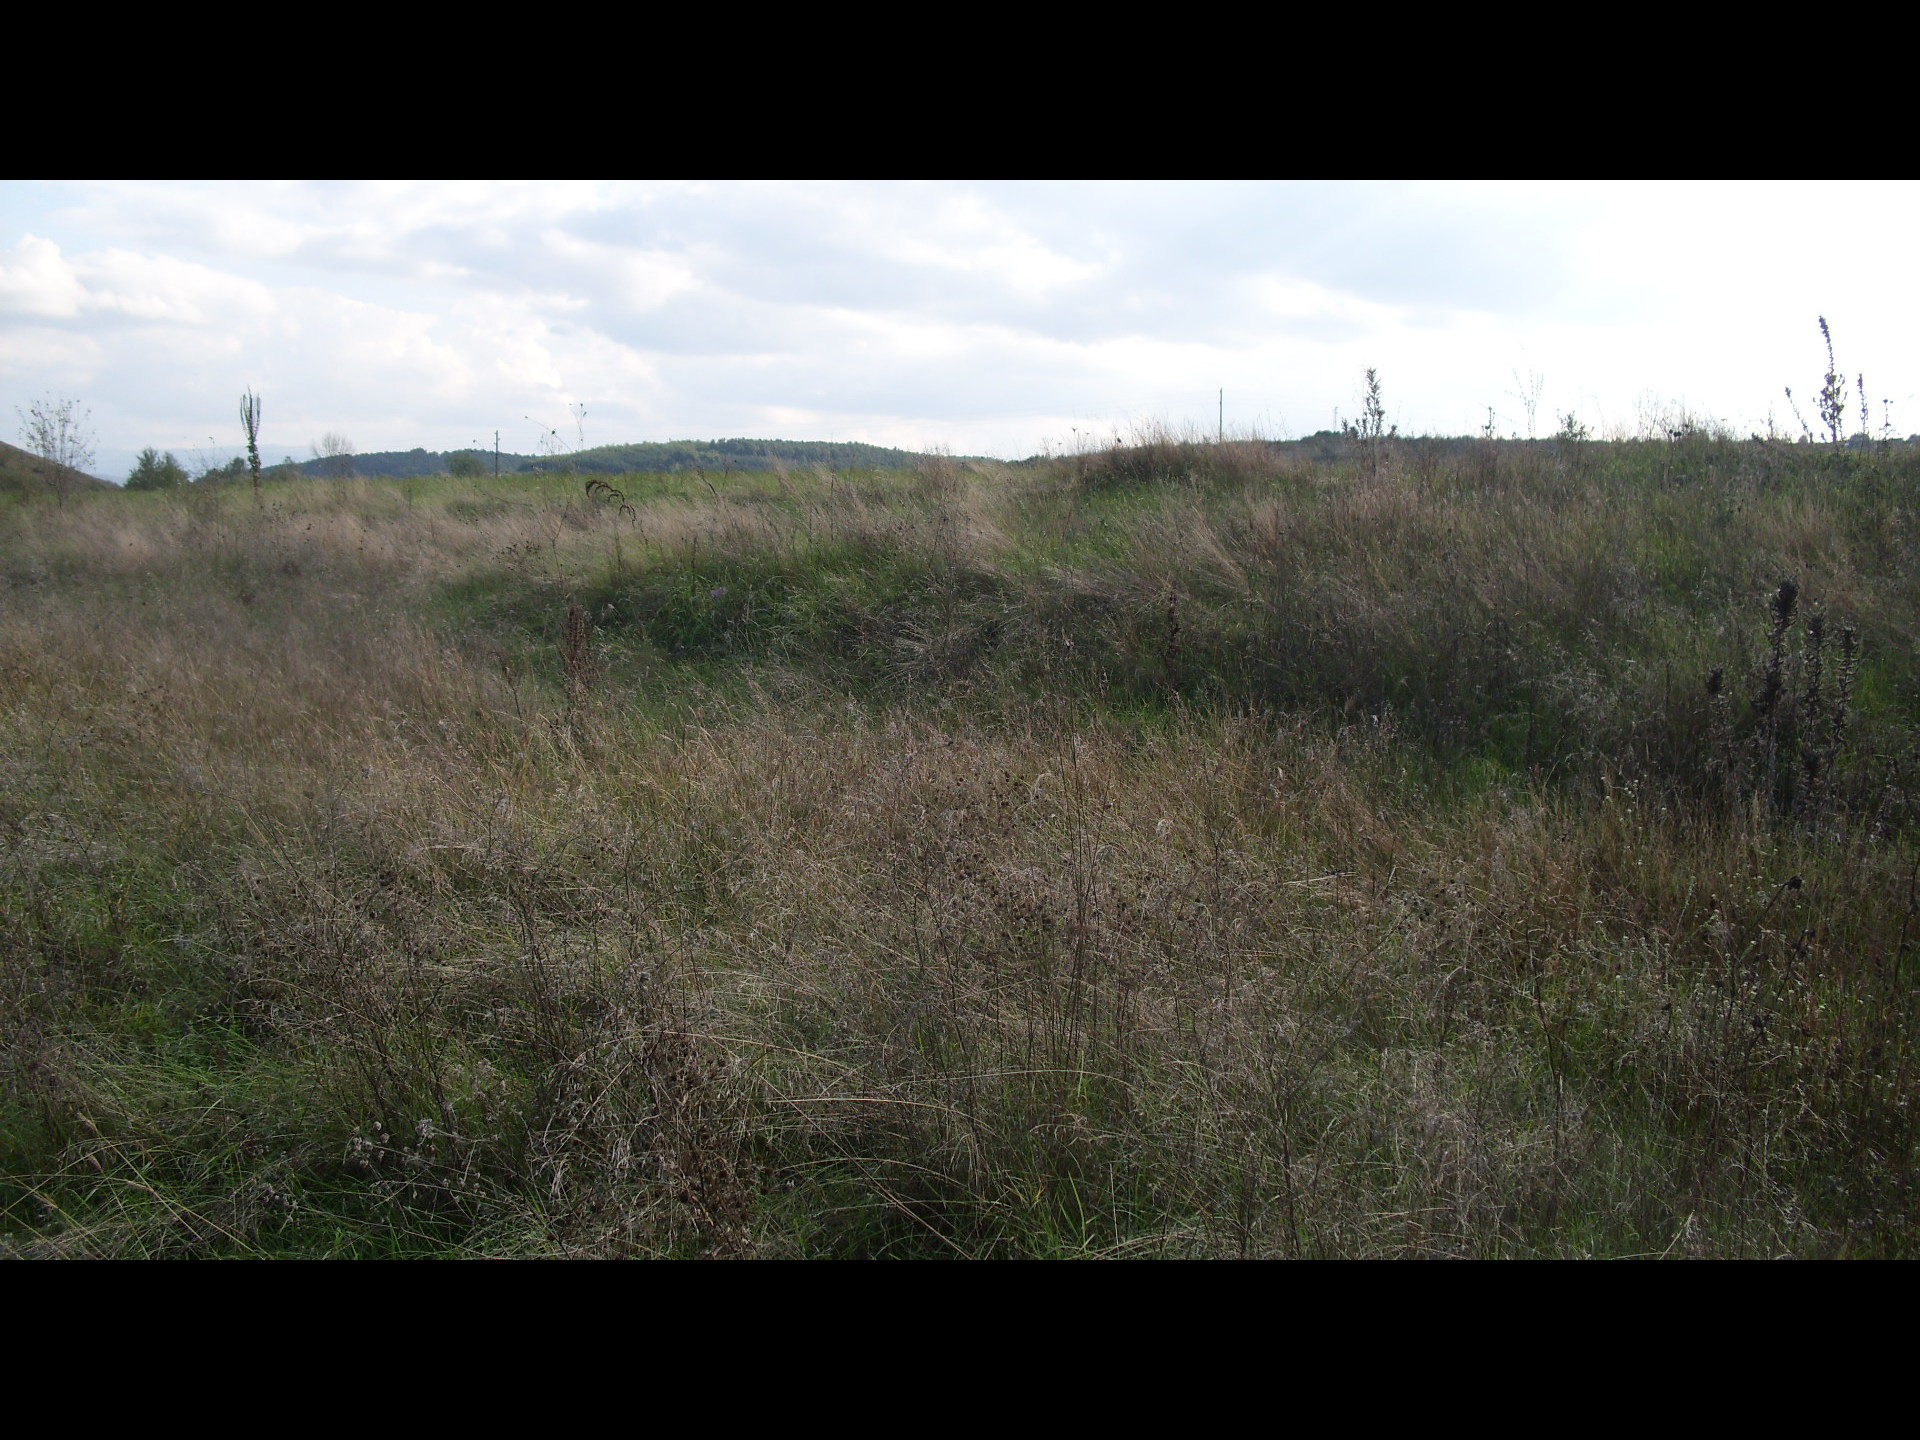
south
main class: Woodland
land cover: Broadleaved woodland
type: mesophytic deciduous forest
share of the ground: > 75 %
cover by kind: broadleaved forest trees 100 %
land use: Forestry
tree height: < 5 m
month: October
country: BG
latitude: 43.4002
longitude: 23.2890
